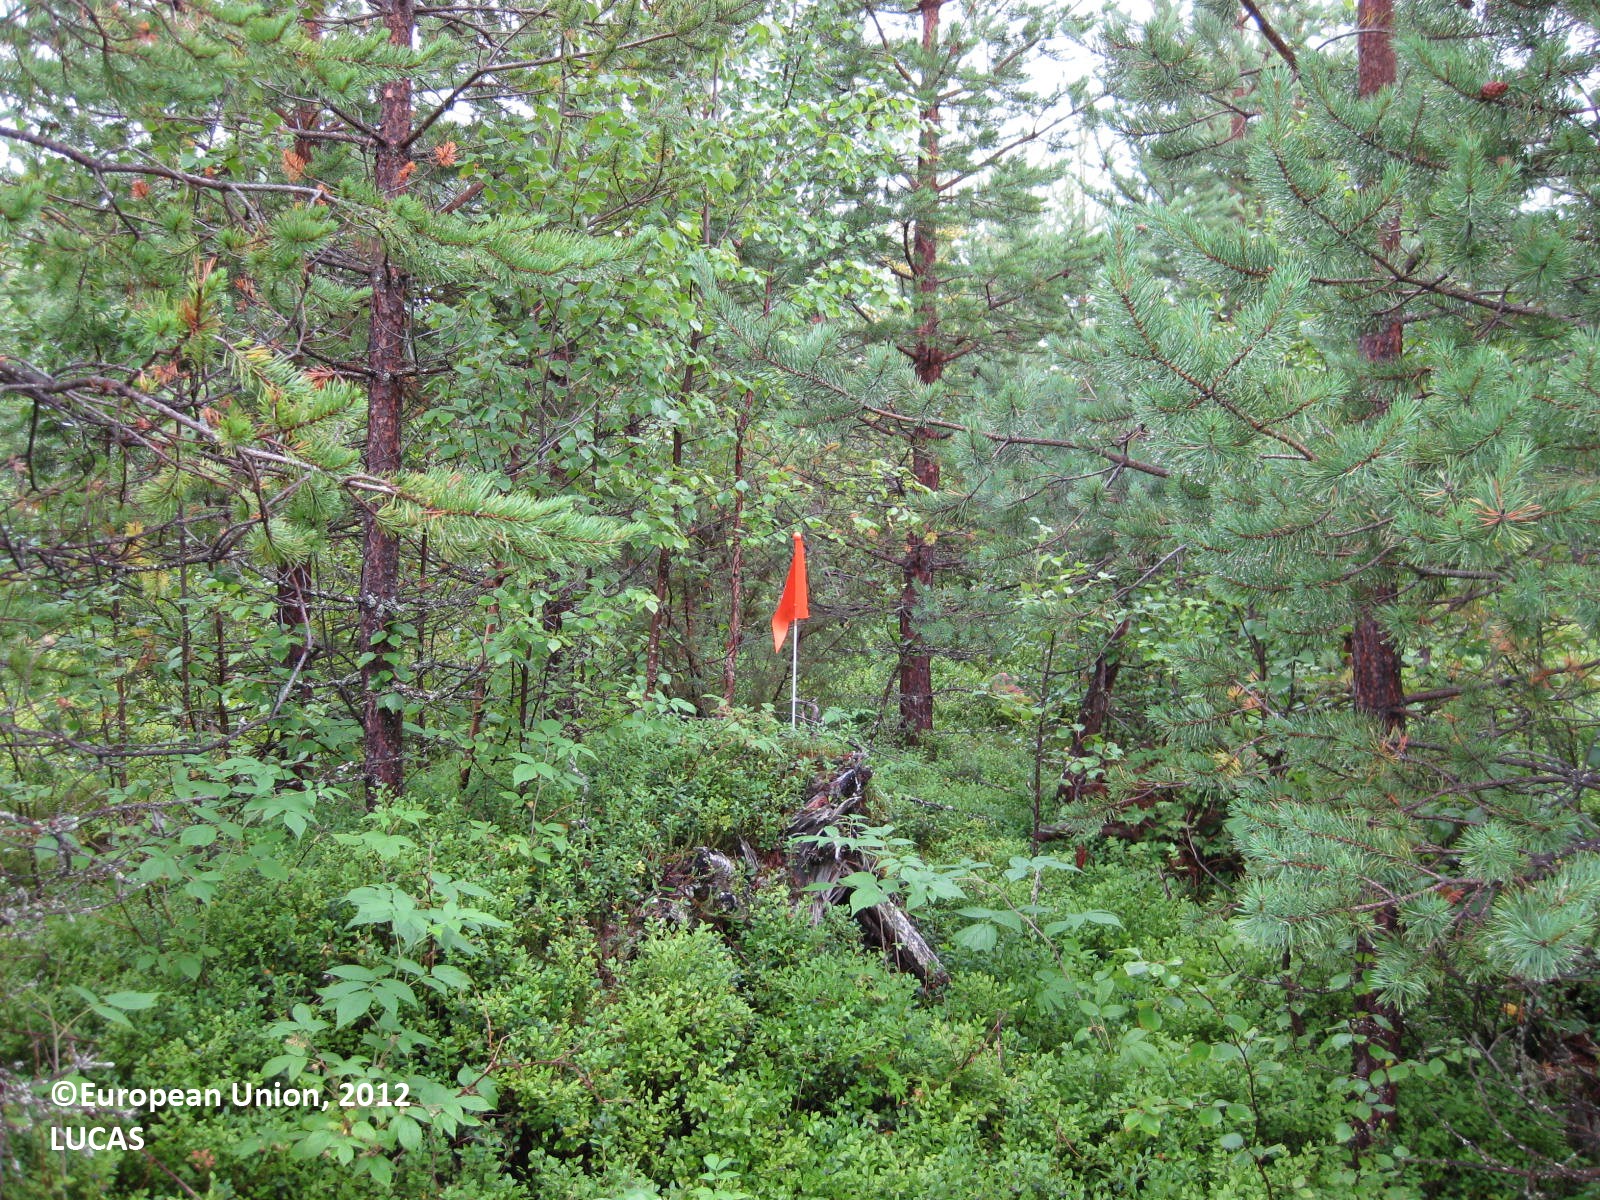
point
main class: Woodland
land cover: Pine dominated mixed woodland
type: boreal forest
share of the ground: > 75 %
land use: Forestry
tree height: > 5 m
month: August
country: FI
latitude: 66.0940
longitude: 28.2104
